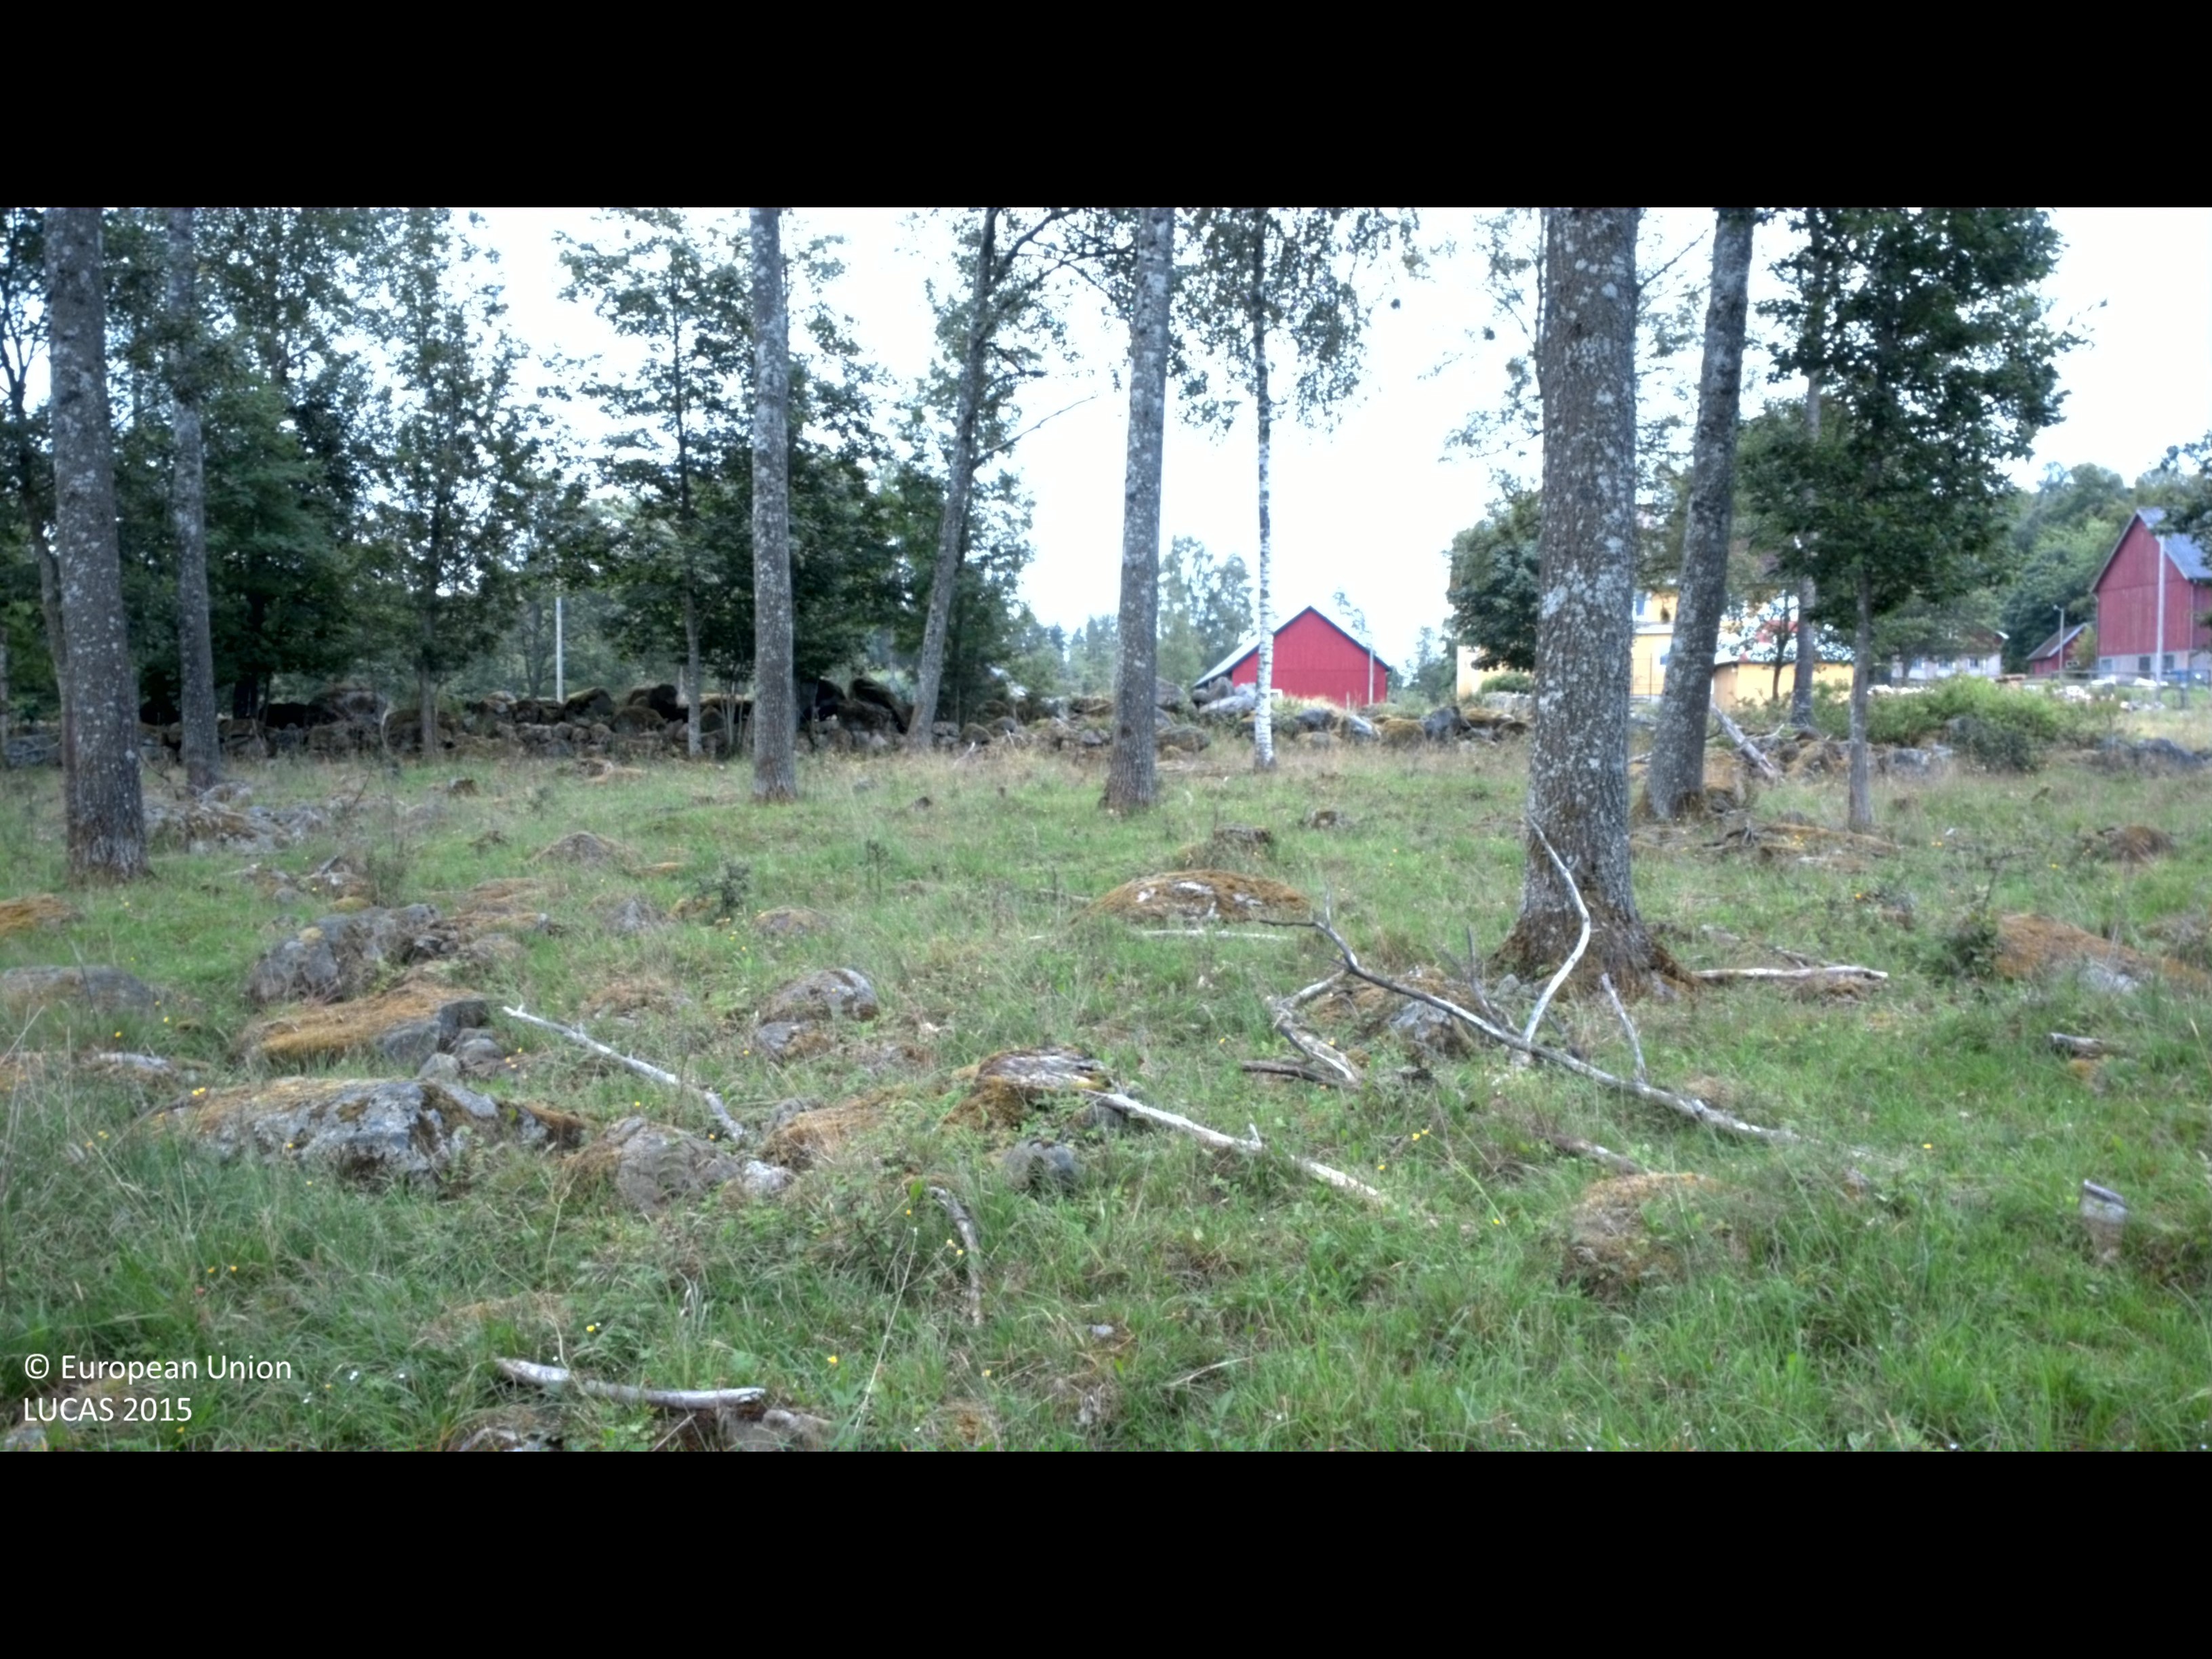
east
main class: Woodland
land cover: Broadleaved woodland
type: non-riverine alder, birch or aspen forest
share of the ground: 25 - 50 %
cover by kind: broadleaved forest trees 40 %, herbaceous plants 40 %, shrubs 10 %, consolidated bare surface 10 %
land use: Agriculture (excluding fallow land and kitchen gardens)
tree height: > 5 m
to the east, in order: Broadleaved woodland; Dry stone walls; Grassland without tree/shrub cover; Fences; Spontaneously vegetated surfaces; Tracks; Grassland without tree/shrub cover; Artificial constructions in urban areas; Grassland with sparse tree/shrub cover; Paved roads, cycling and walking lanes; Grass margins; Dry stone walls; Shrubland with sparse tree cover; Grassland without tree/shrub cover; Groves; Dry stone walls
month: July
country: SE
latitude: 56.4895
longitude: 14.4312
